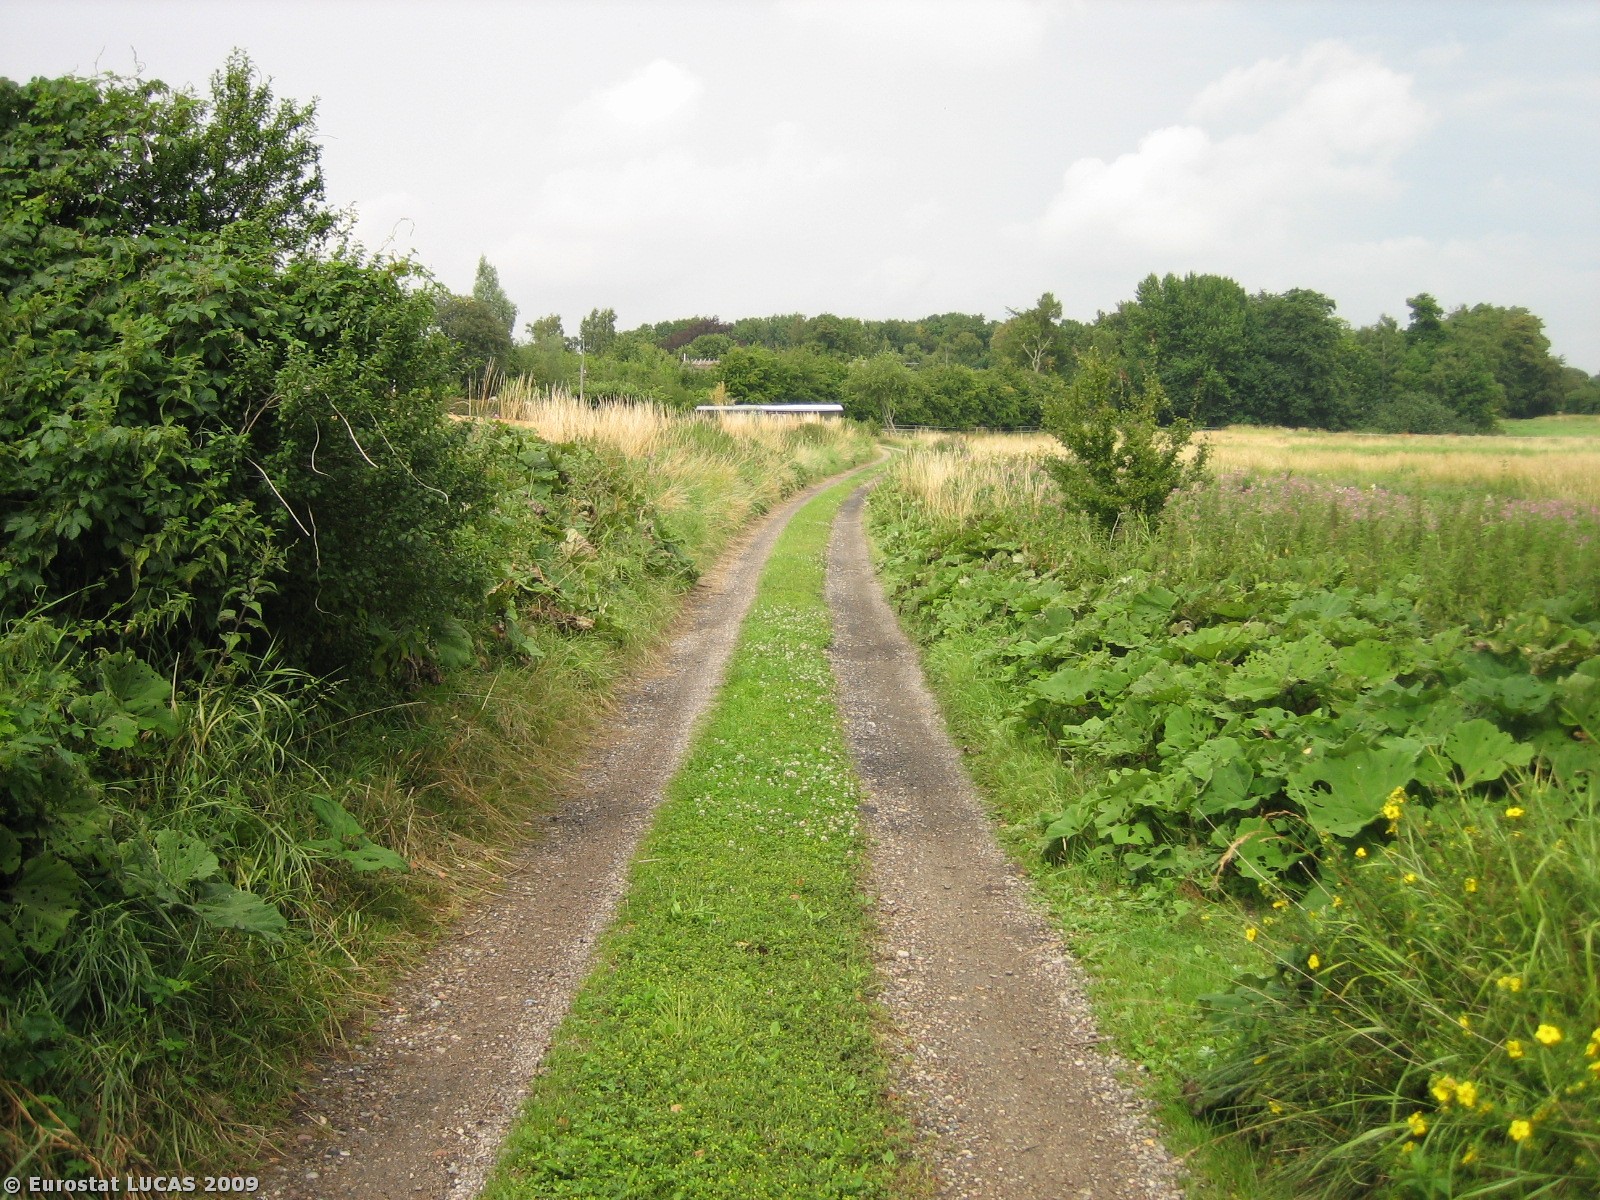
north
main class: Woodland
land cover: Broadleaved woodland
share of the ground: > 75 %
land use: Residential
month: July
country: DK
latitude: 55.3249
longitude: 9.9213
